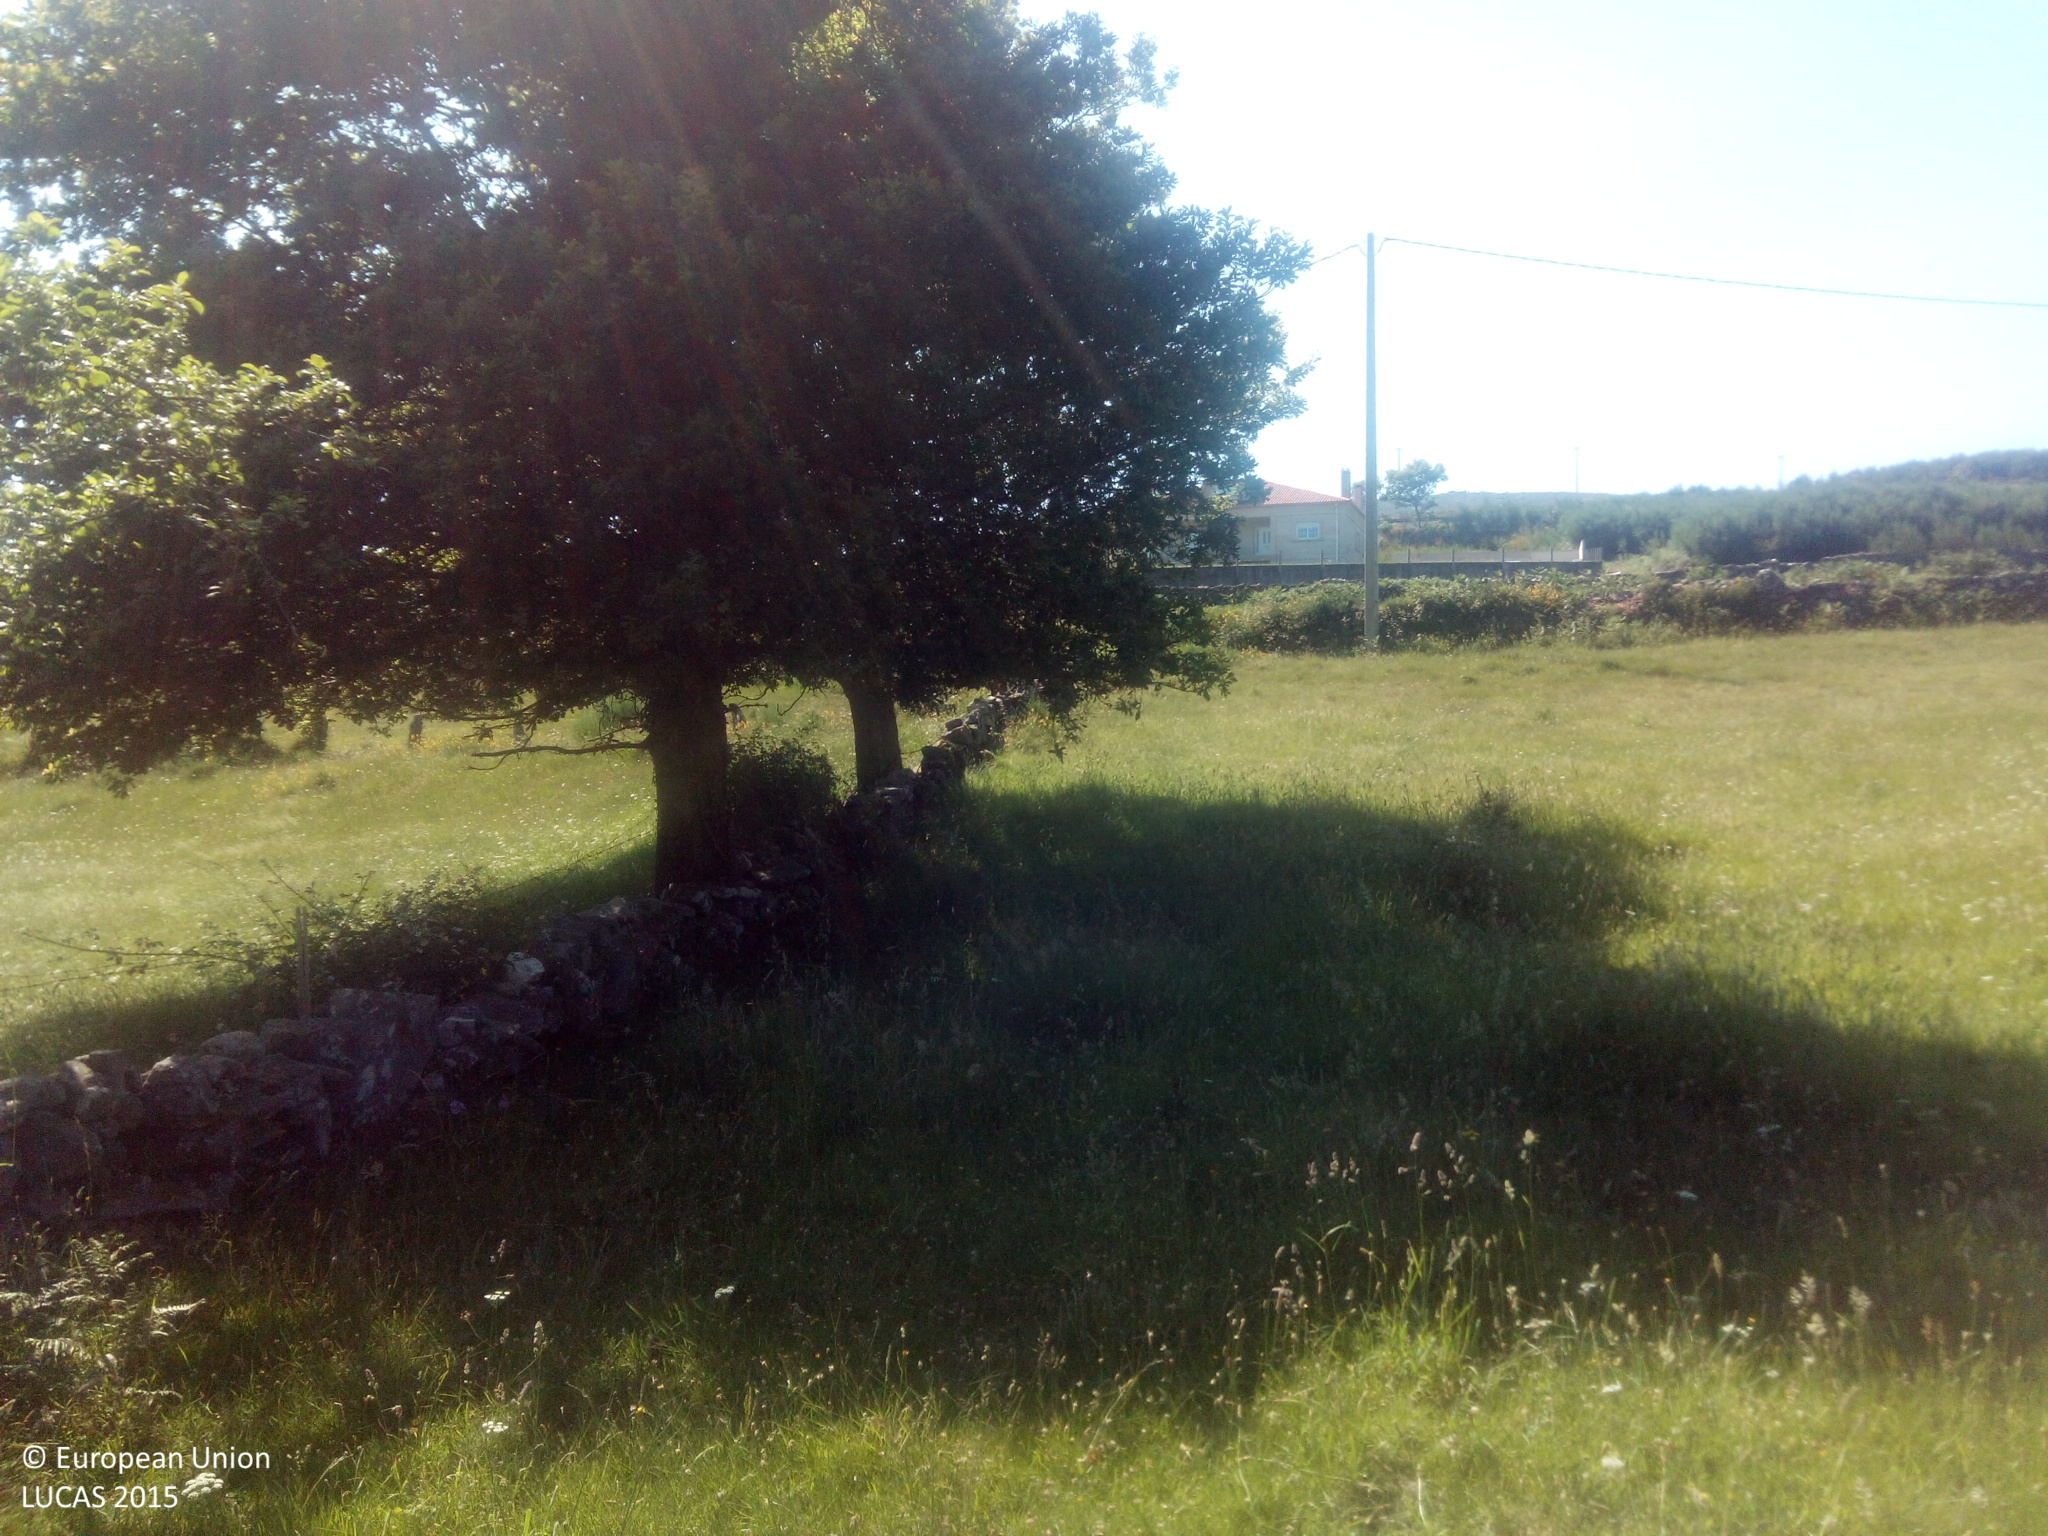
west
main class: Grassland
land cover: Grassland without tree/shrub cover
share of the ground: > 75 %
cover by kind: herbaceous plants 100 %
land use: Agriculture (excluding fallow land and kitchen gardens)
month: June
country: ES
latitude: 42.4313
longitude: -8.3874
